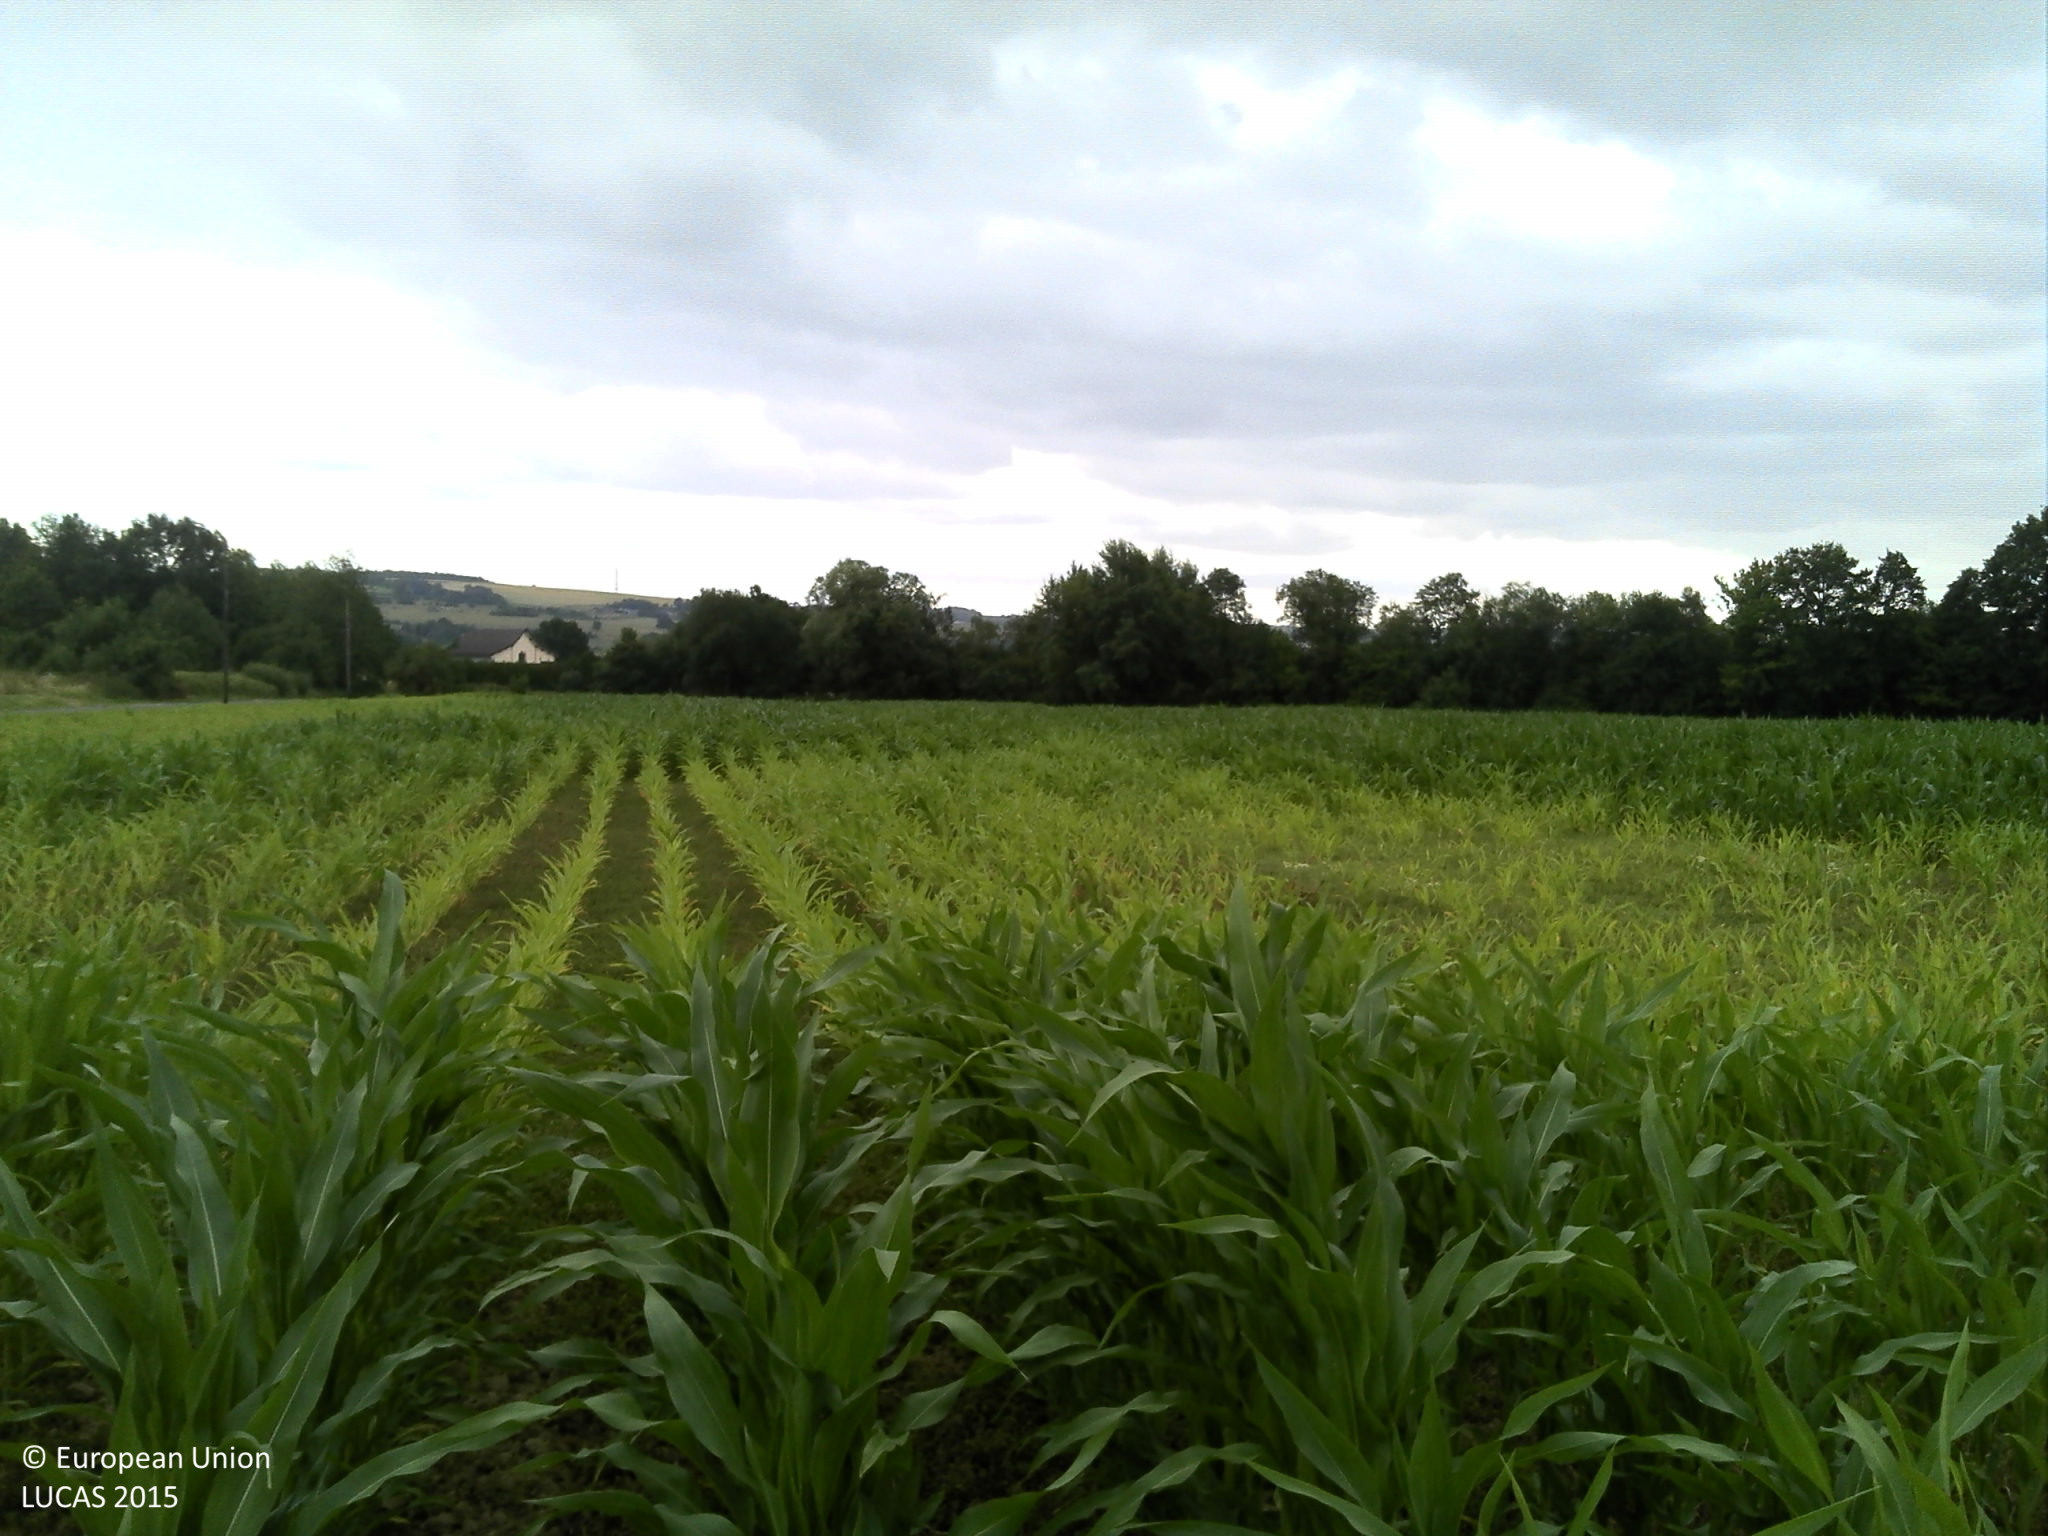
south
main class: Cropland
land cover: Maize
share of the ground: 25 - 50 %
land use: Agriculture (excluding fallow land and kitchen gardens)
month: July
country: FR
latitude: 49.8036
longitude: 4.5914
